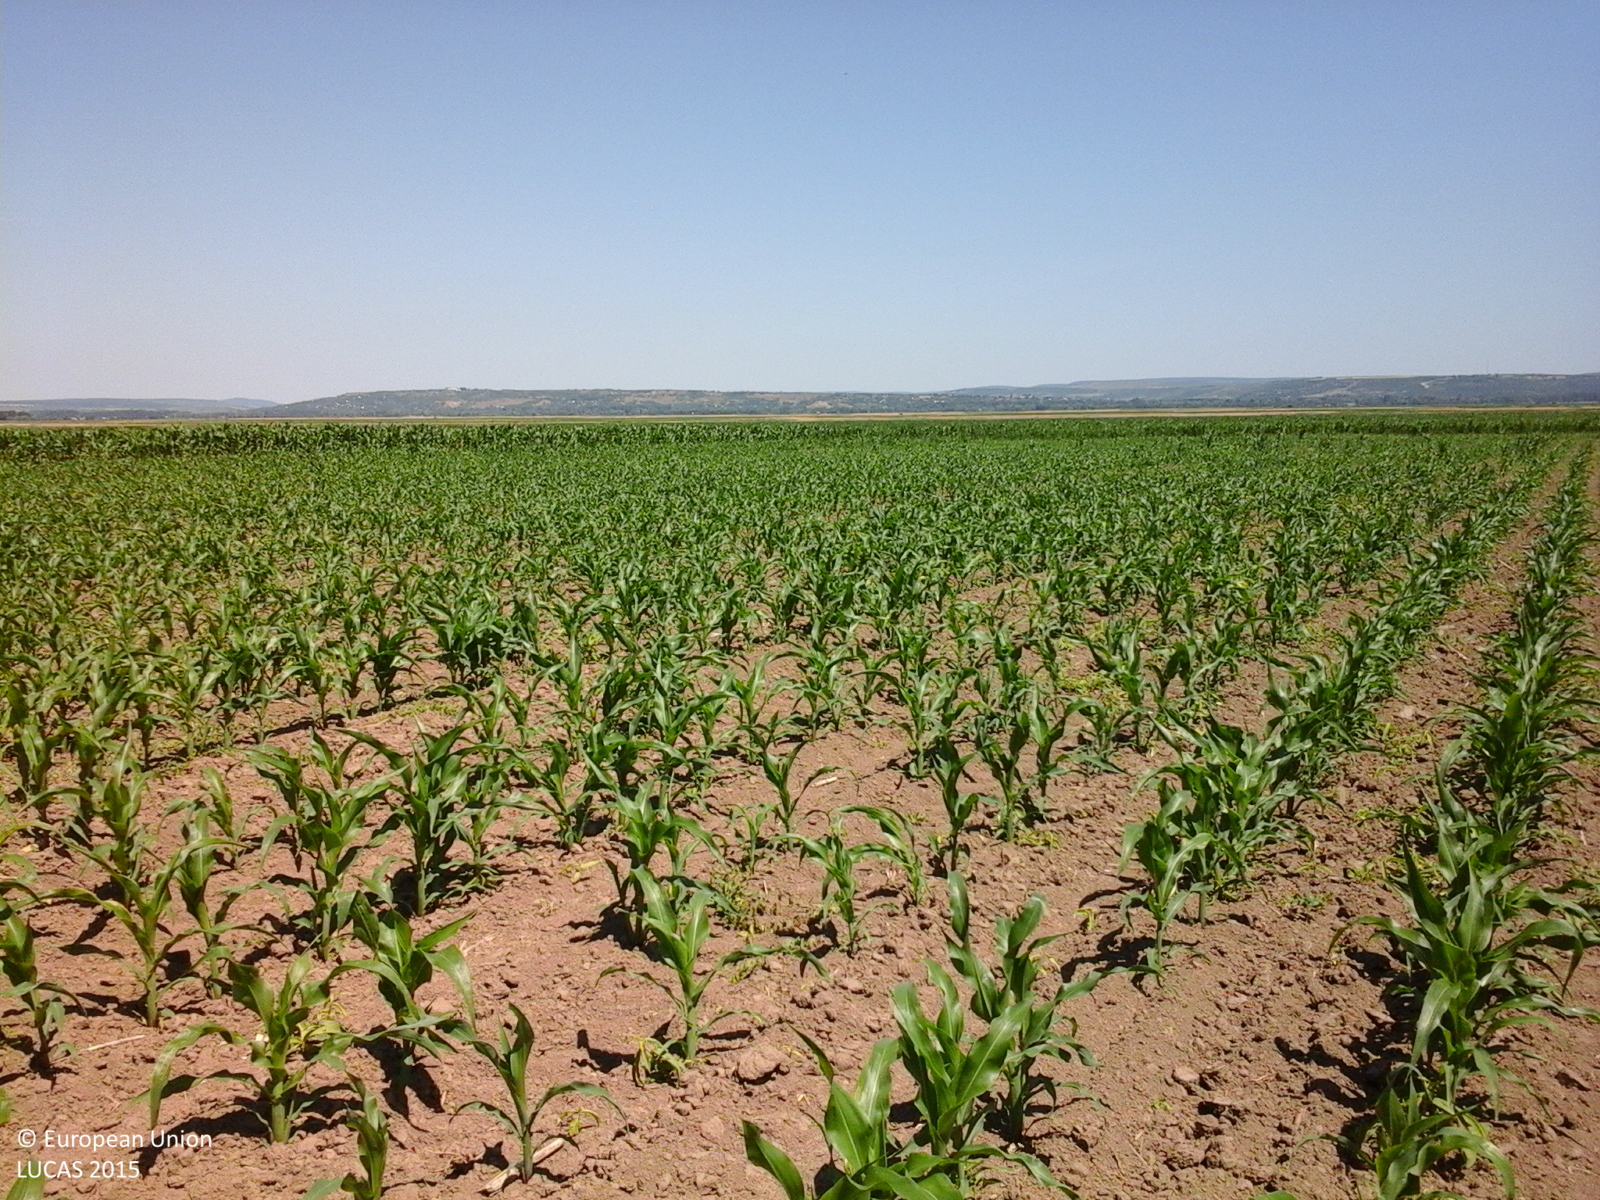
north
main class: Cropland
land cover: Maize
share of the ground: 25 - 50 %
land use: Agriculture (excluding fallow land and kitchen gardens)
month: June
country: RO
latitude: 46.9881
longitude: 27.9716
